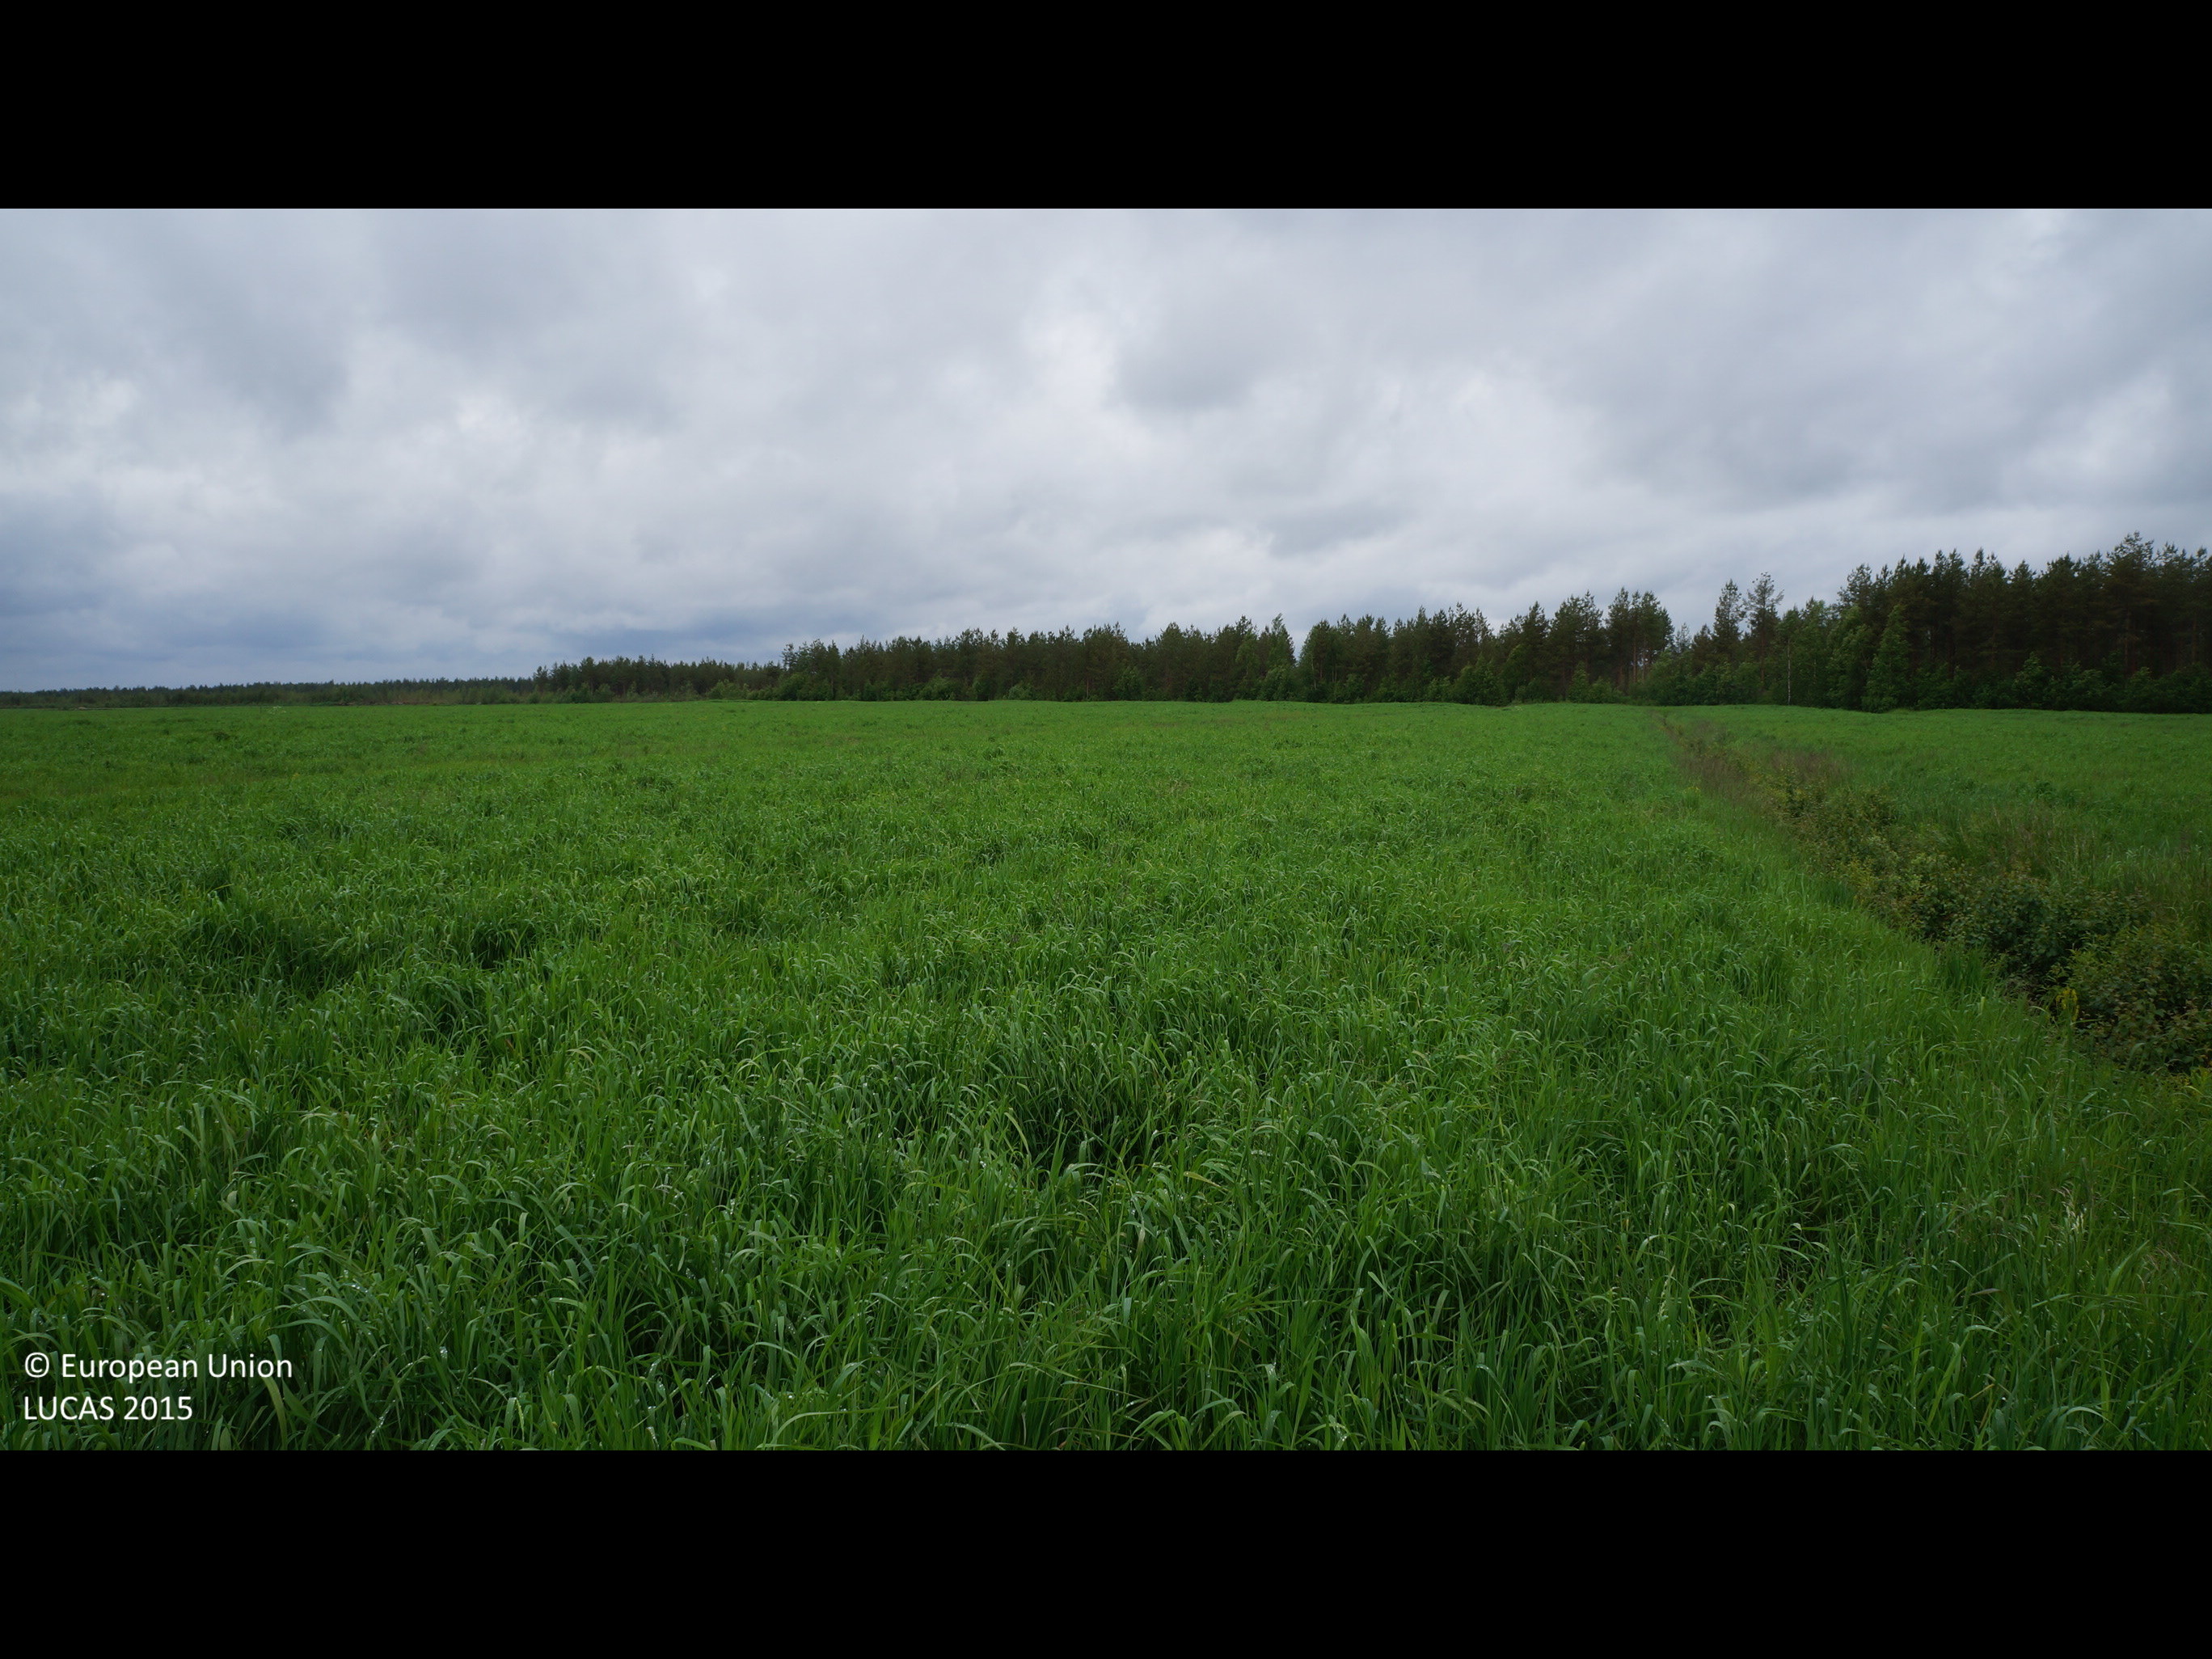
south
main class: Cropland
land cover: Temporary grasslands
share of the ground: > 75 %
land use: Agriculture (excluding fallow land and kitchen gardens)
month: June
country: FI
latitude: 64.6612
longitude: 25.3513
